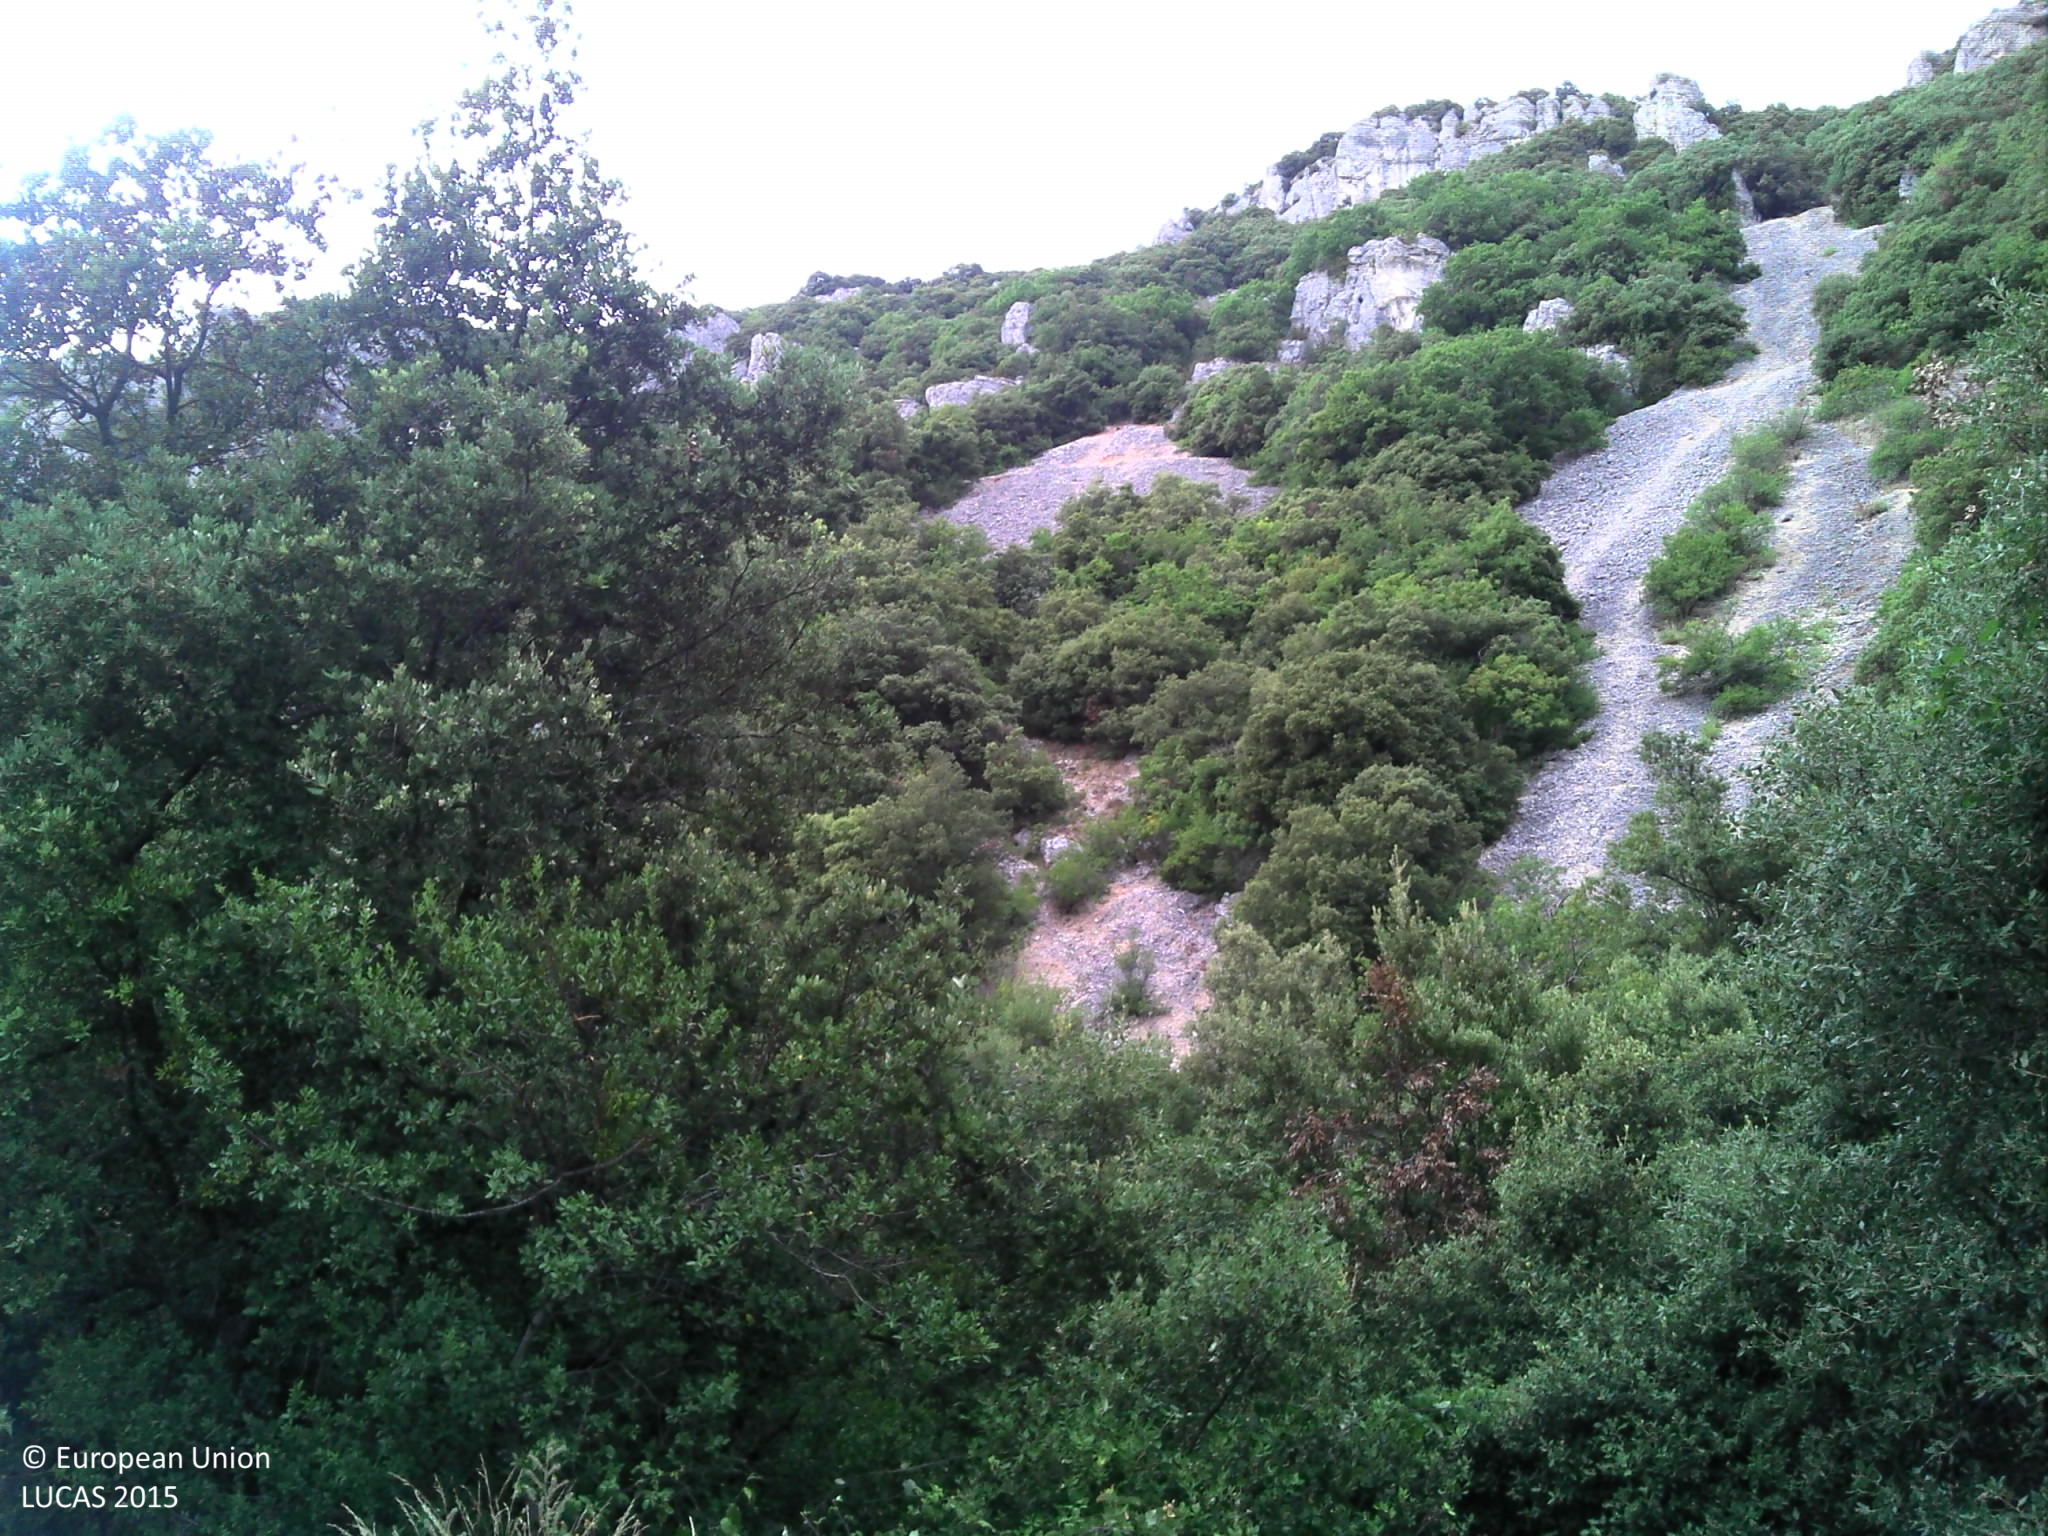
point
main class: Woodland
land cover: Broadleaved woodland
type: broadleaved evergreen forest
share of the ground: > 75 %
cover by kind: broadleaved forest trees 50 %
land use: Semi-natural and natural areas not in use
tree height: > 5 m
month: July
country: FR
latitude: 44.4458
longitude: 4.6164
